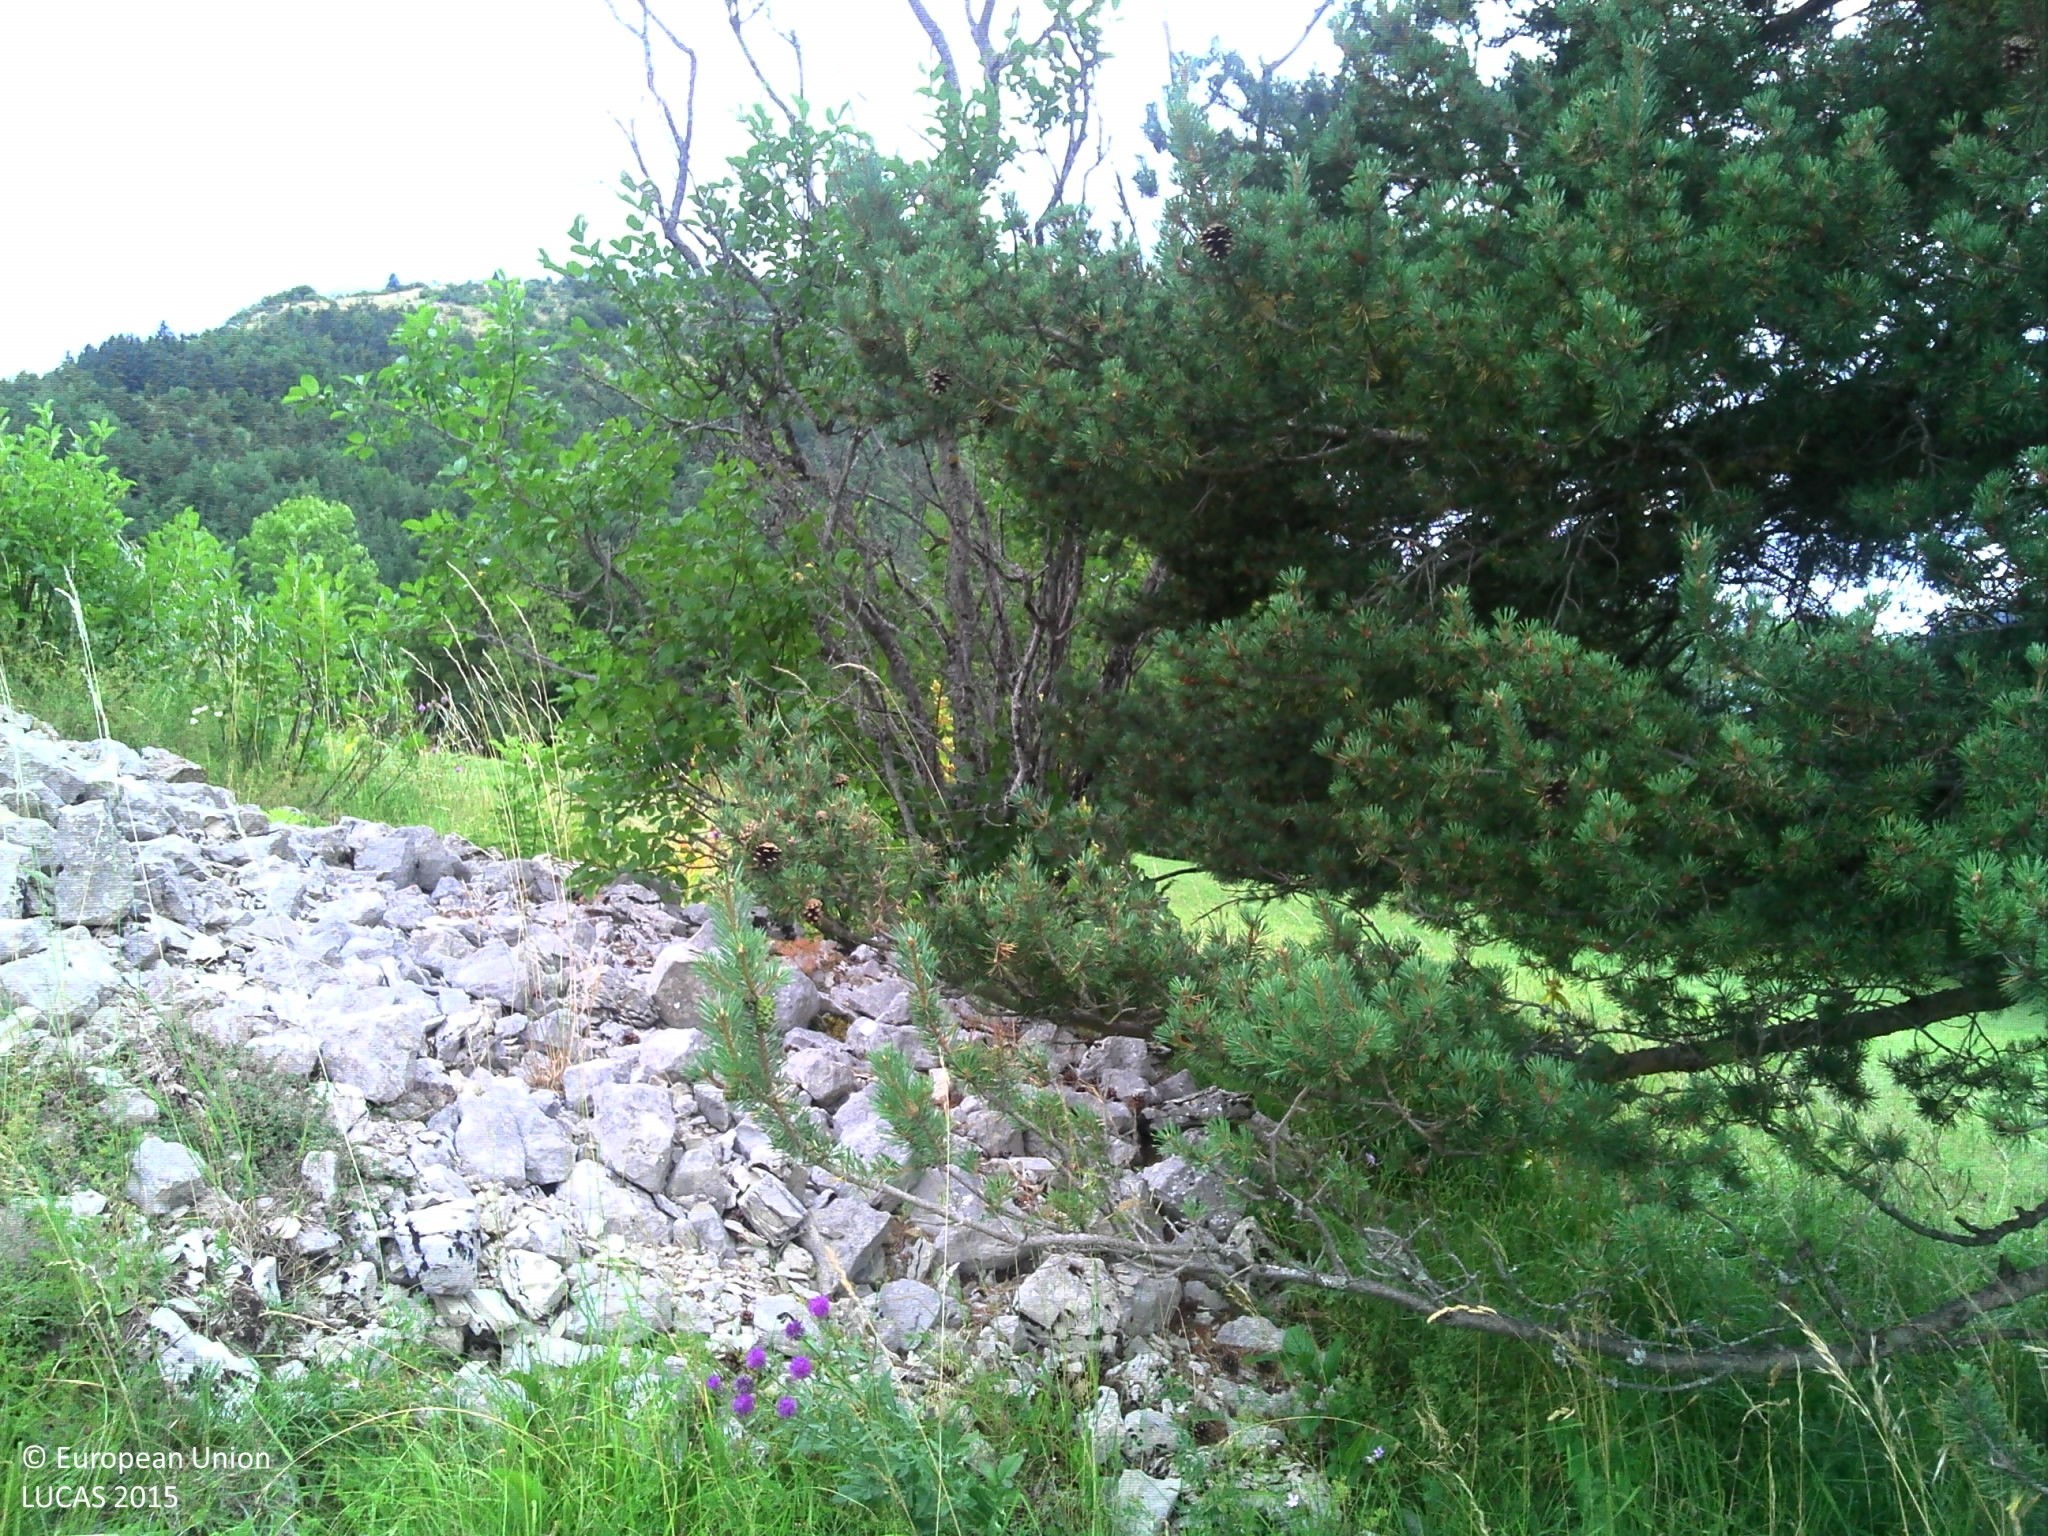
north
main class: Grassland
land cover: Grassland with sparse tree/shrub cover
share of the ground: > 75 %
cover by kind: herbaceous plants 85 %, coniferous forest trees 5 %, shrubs 5 %, consolidated bare surface 5 %
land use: Agriculture (excluding fallow land and kitchen gardens)
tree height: < 5 m
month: July
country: FR
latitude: 44.9057
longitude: 5.5606
